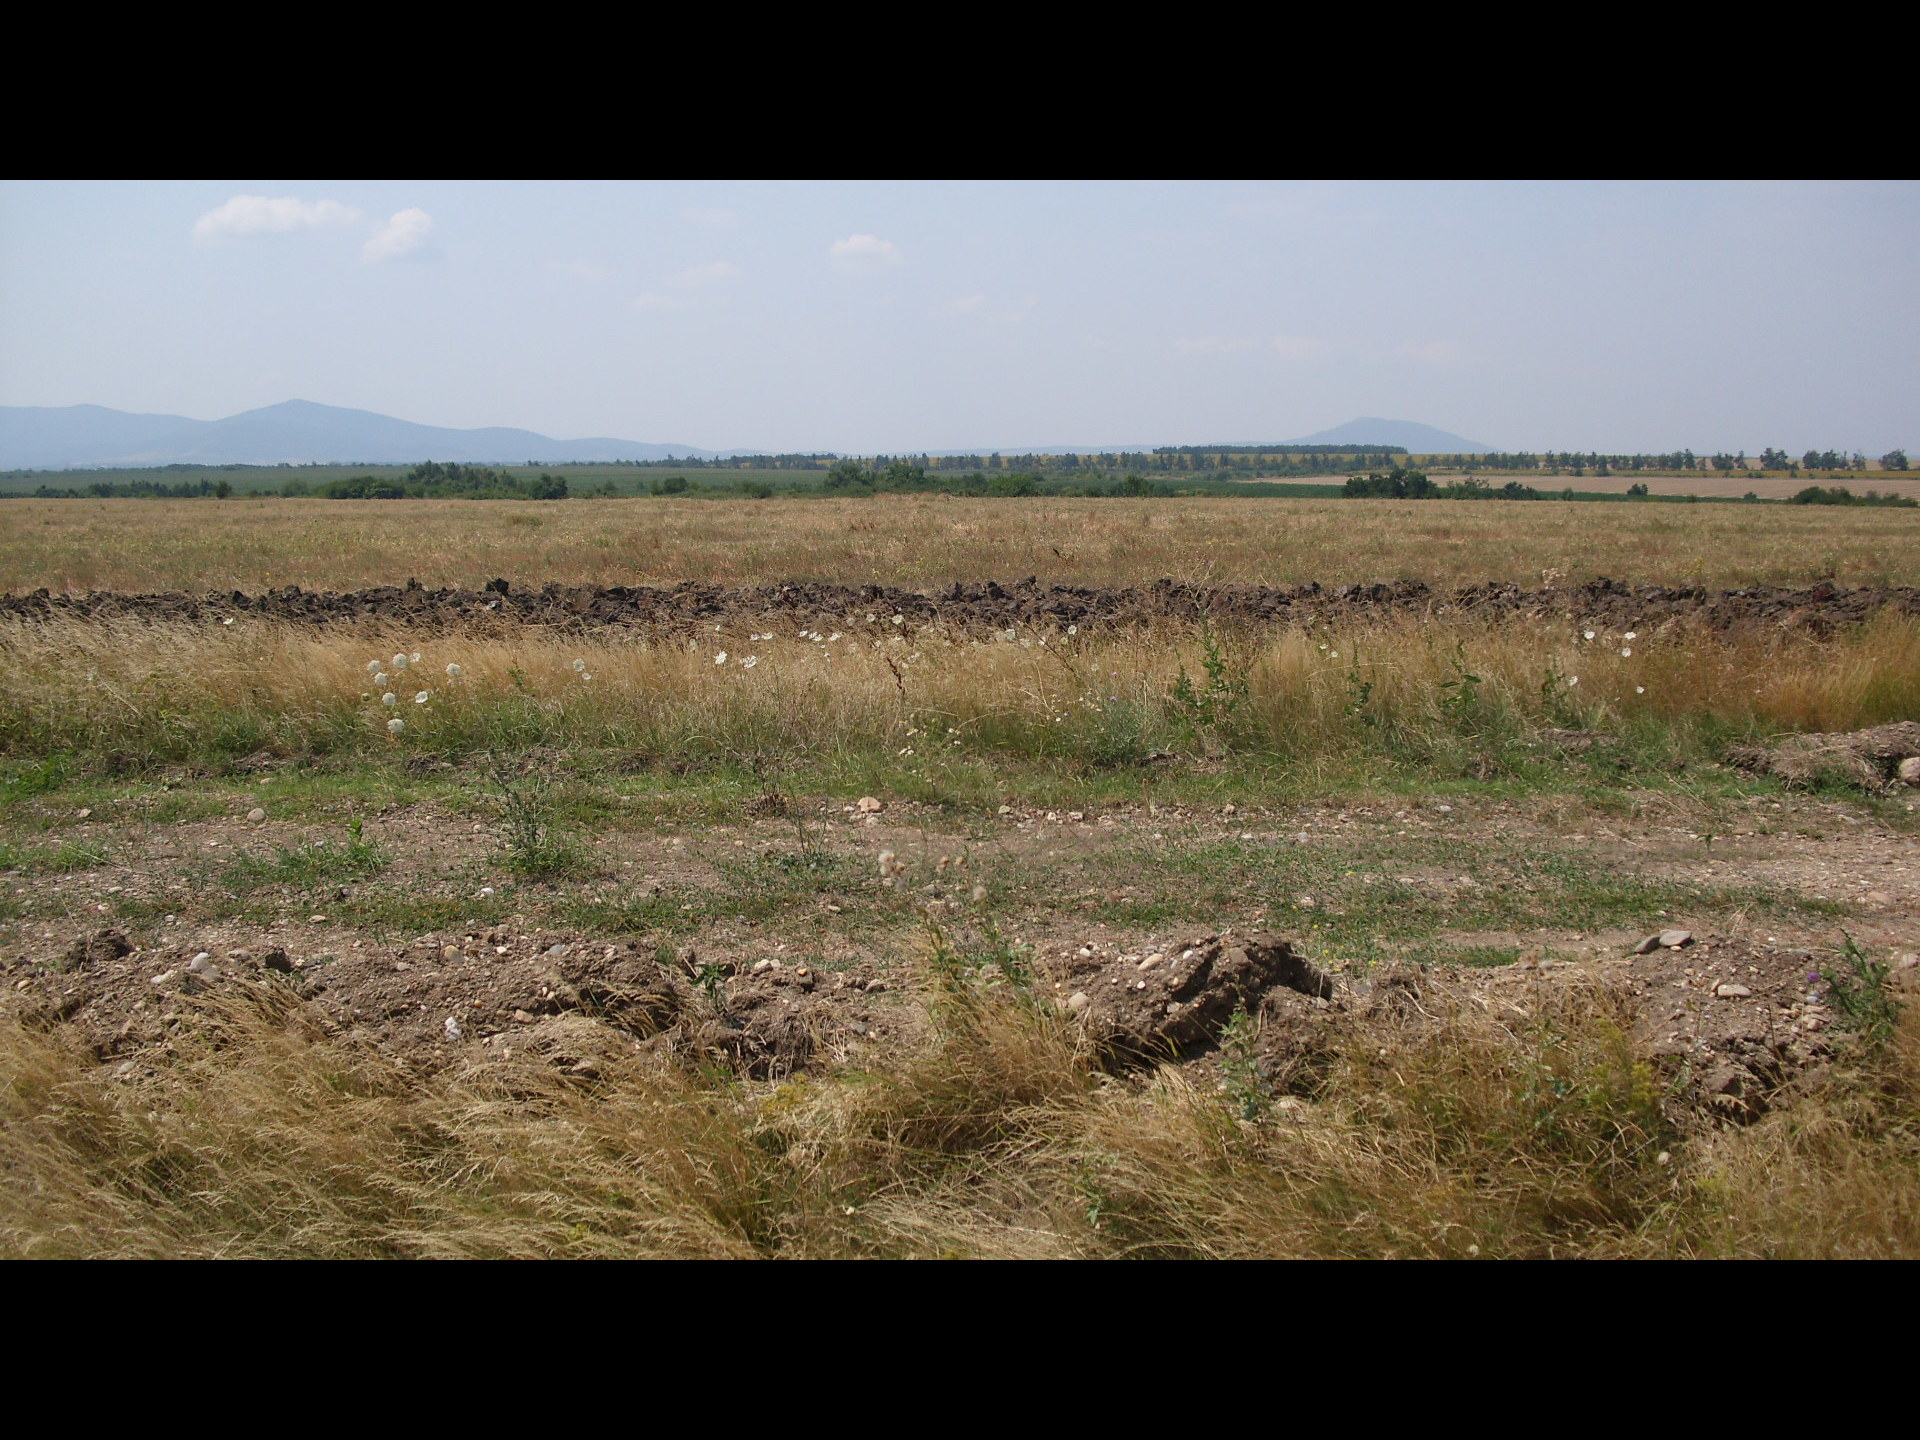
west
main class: Cropland
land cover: Soya
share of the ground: > 75 %
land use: Agriculture (excluding fallow land and kitchen gardens)
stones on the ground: < 10 %
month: July
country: BG
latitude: 43.8010
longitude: 22.5751
